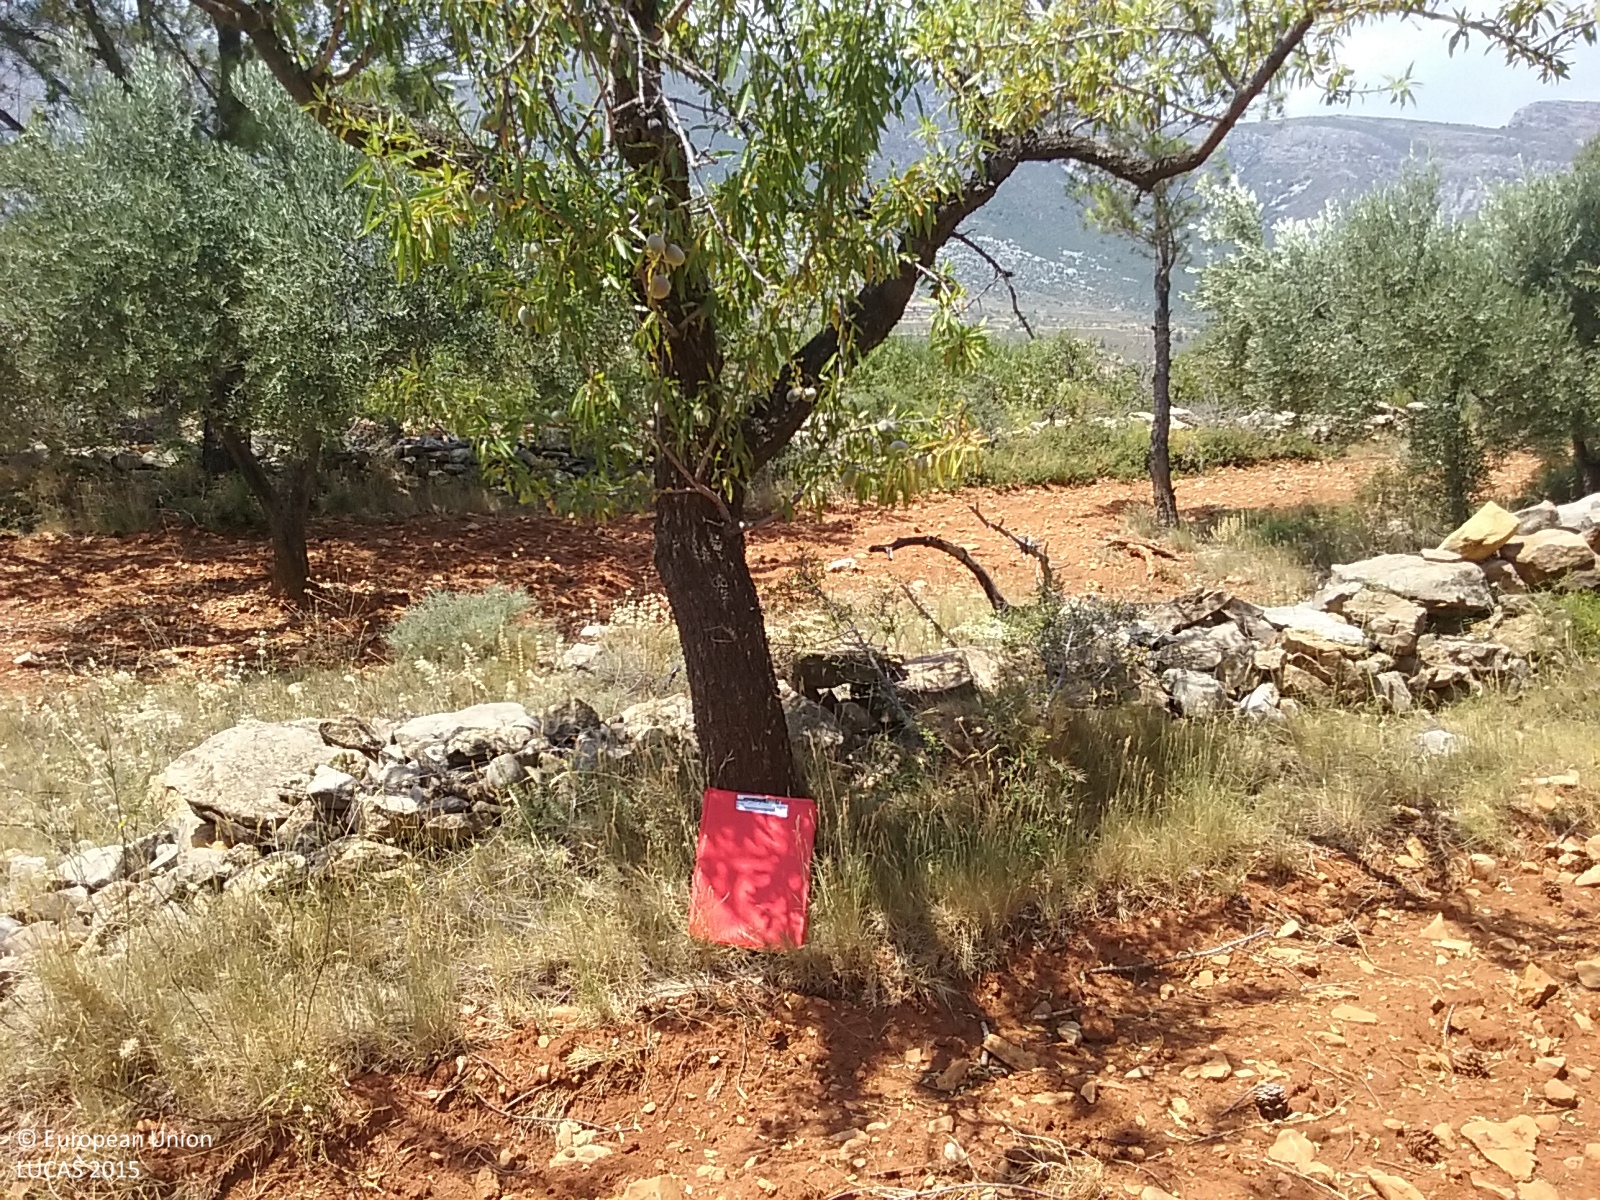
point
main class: Cropland
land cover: Nuts trees
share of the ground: 25 - 50 %
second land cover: Other bare soil
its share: > 75 %
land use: Agriculture (excluding fallow land and kitchen gardens)
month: July
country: ES
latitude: 40.2976
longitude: -0.0391
